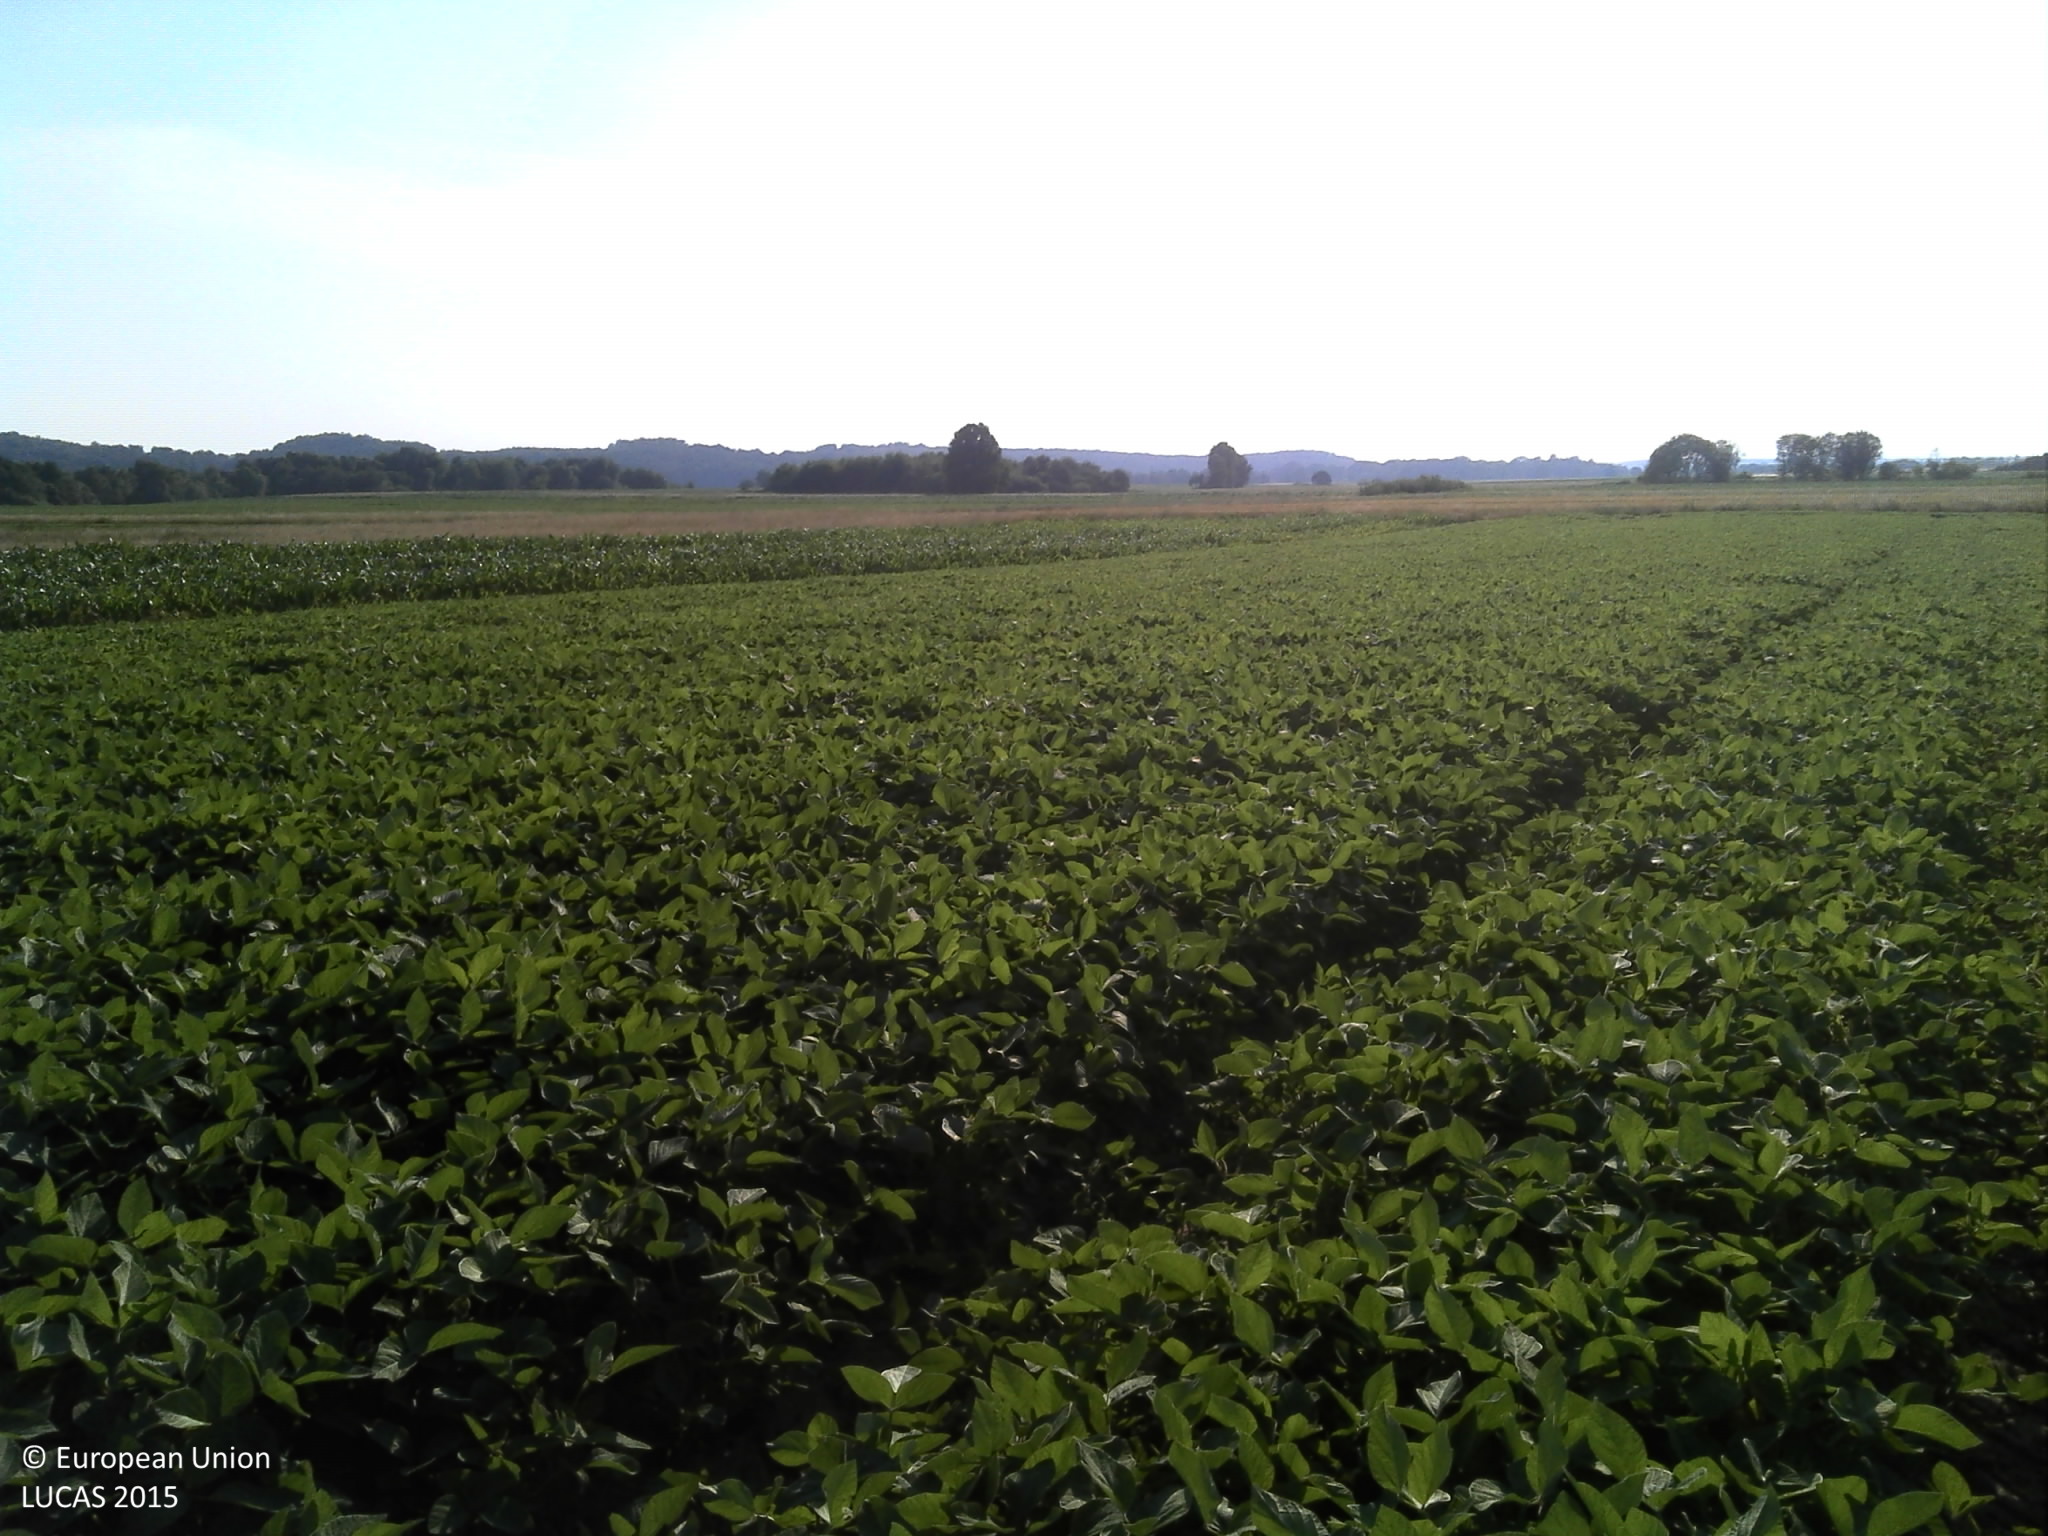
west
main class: Cropland
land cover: Soya
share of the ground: 50 - 75 %
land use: Agriculture (excluding fallow land and kitchen gardens)
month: June
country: HR
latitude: 45.5129
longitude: 17.1815
